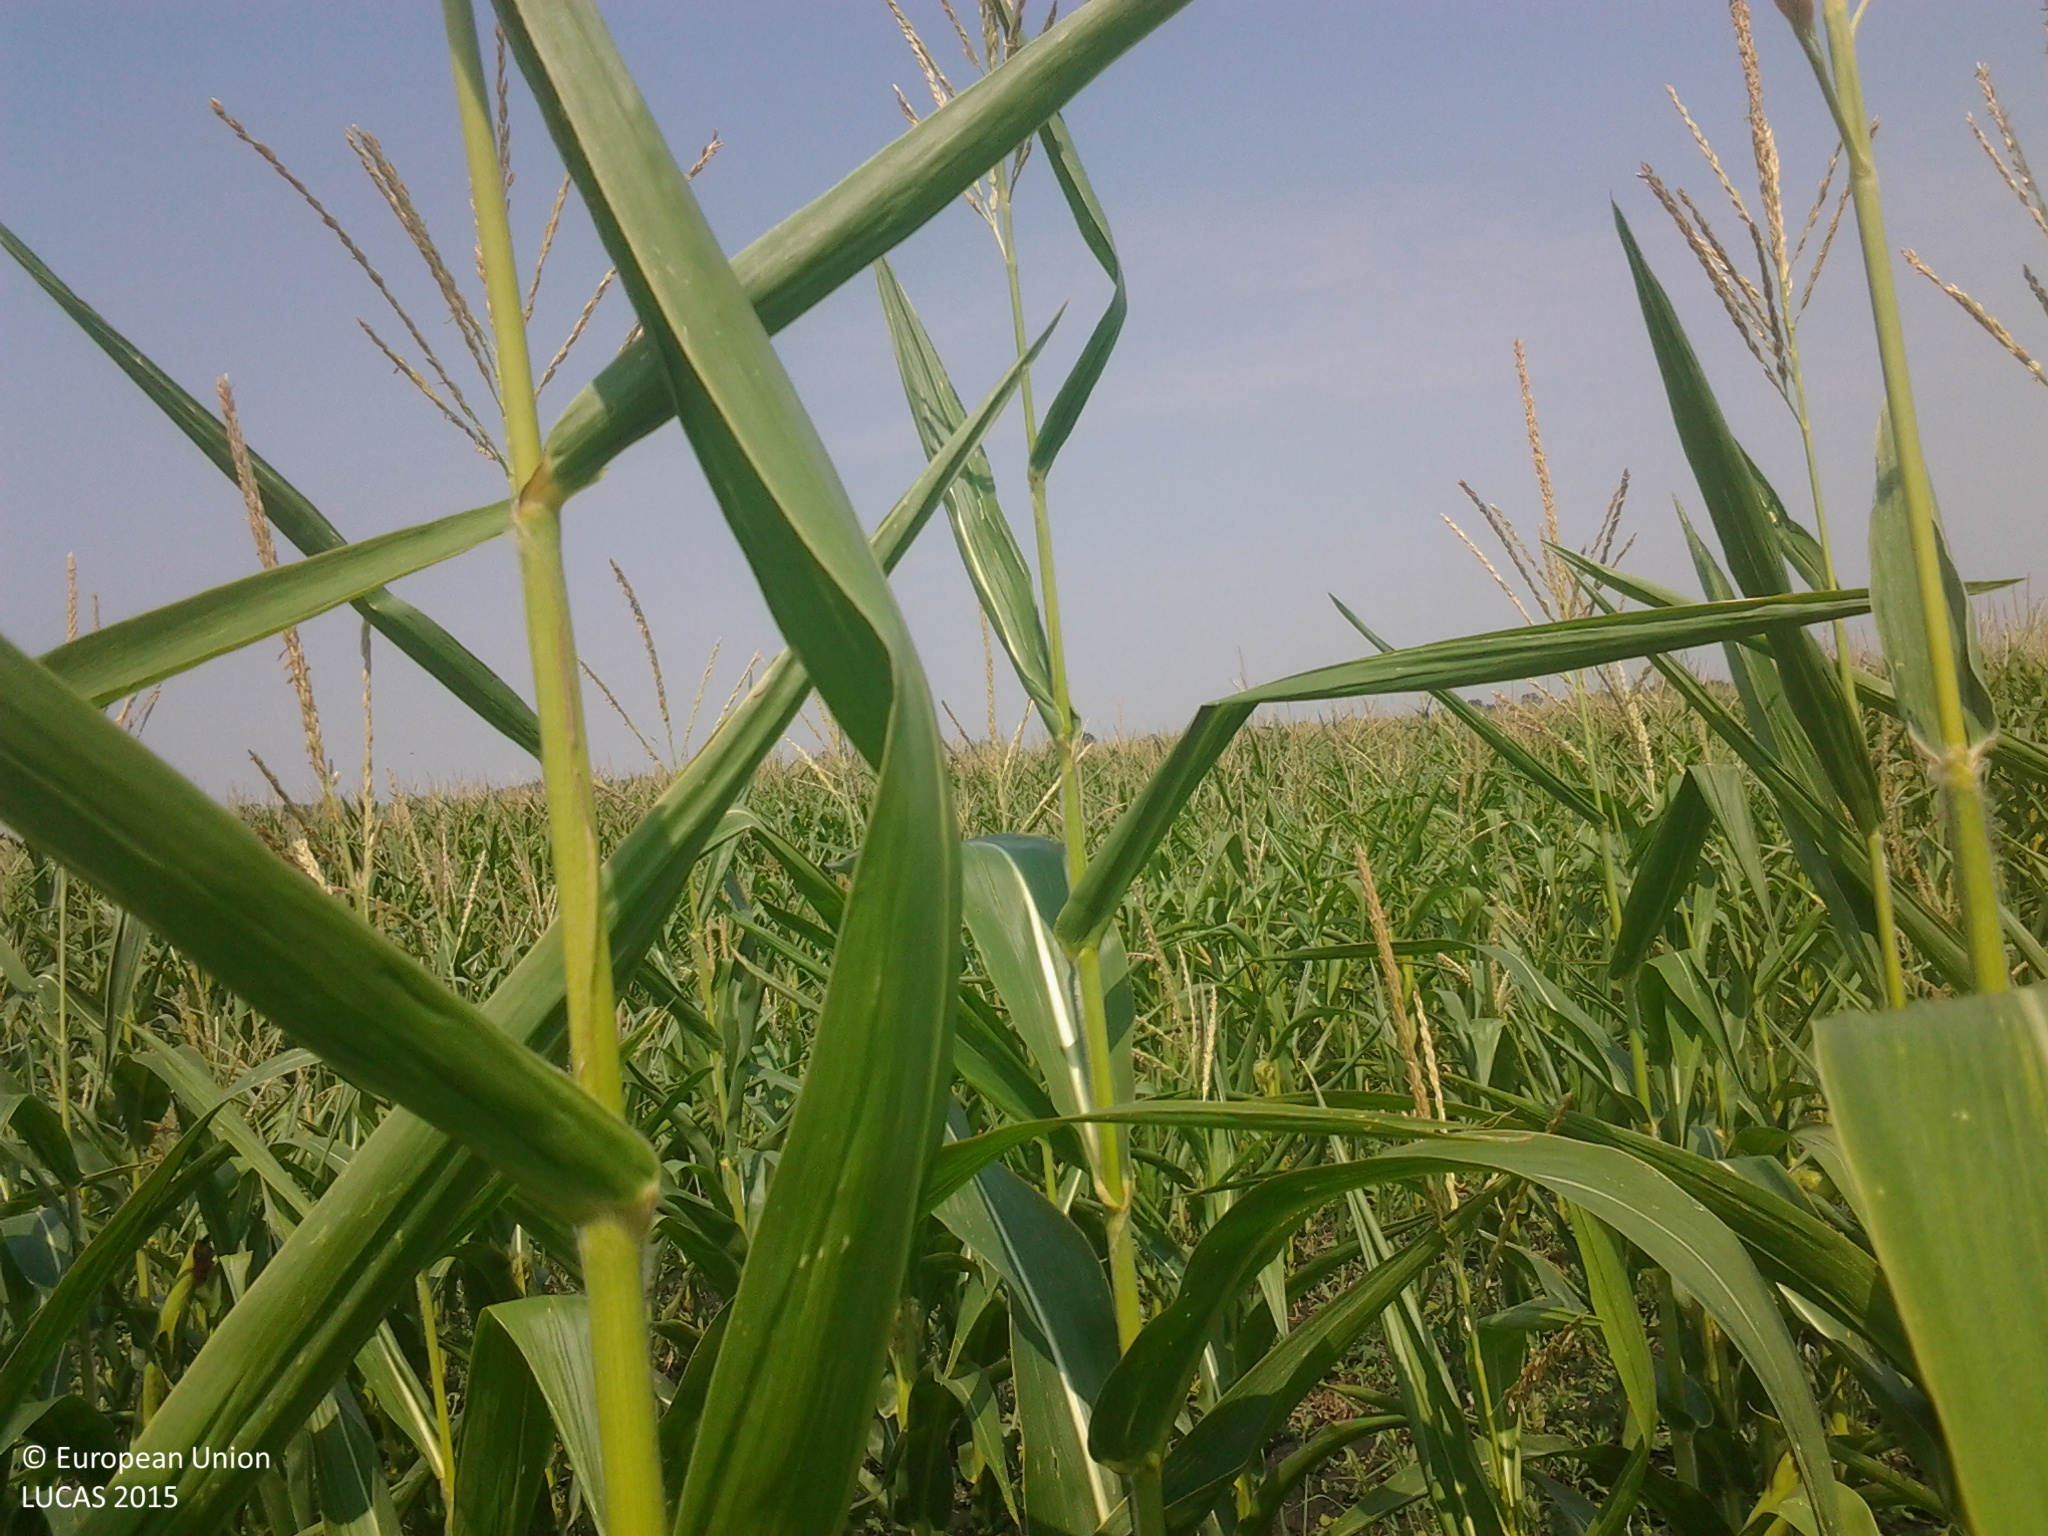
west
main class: Cropland
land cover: Maize
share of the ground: > 75 %
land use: Agriculture (excluding fallow land and kitchen gardens)
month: July
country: HU
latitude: 47.5507
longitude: 20.5694
